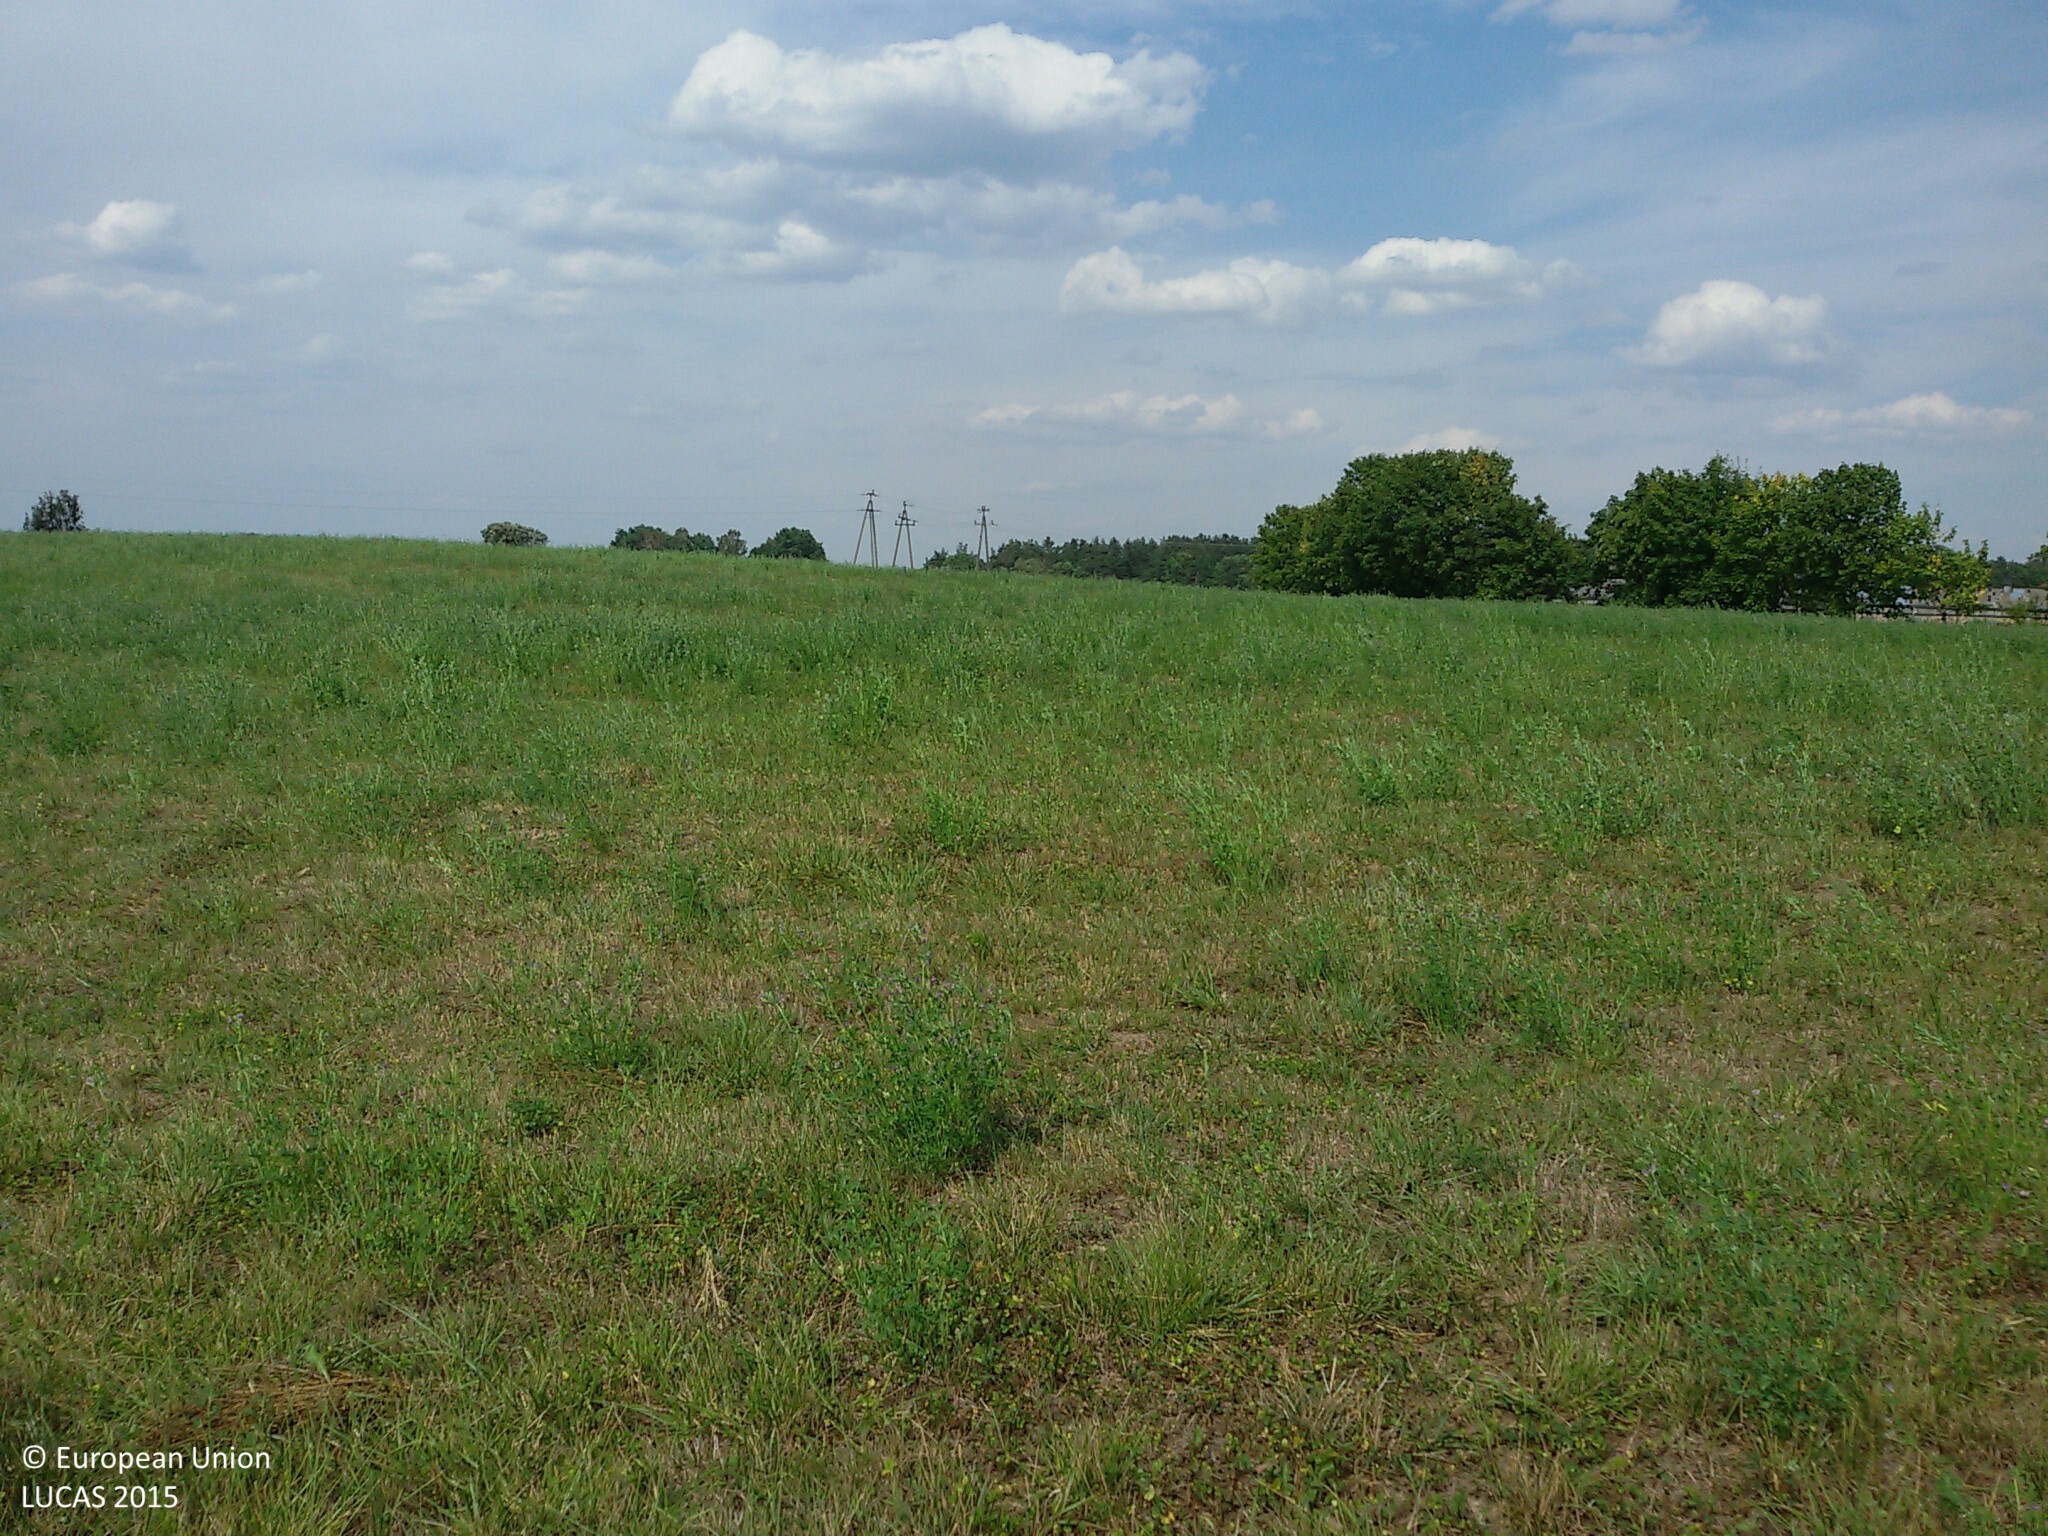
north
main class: Grassland
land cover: Grassland without tree/shrub cover
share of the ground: > 75 %
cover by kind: herbaceous plants 100 %
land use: Agriculture (excluding fallow land and kitchen gardens)
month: August
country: PL
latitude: 53.6067
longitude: 20.1746
